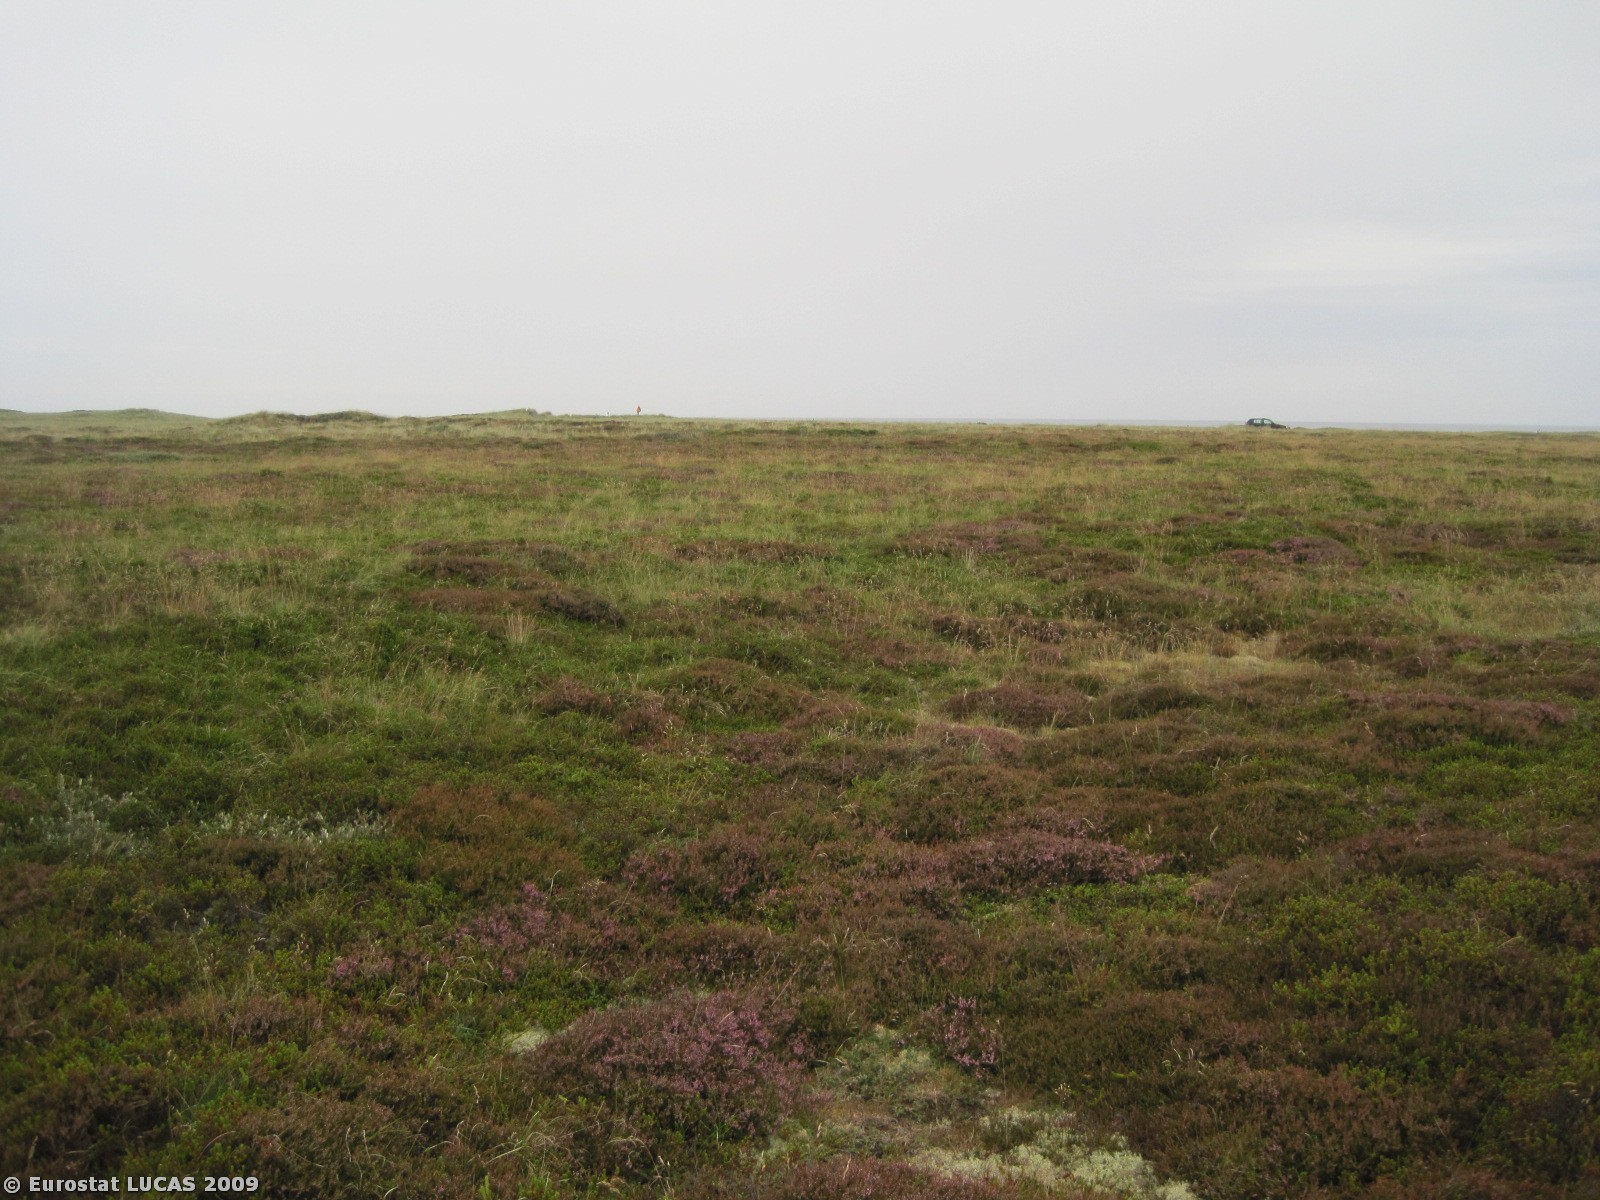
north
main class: Grassland
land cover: Grassland without tree/shrub cover
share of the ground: > 75 %
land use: Nature reserves
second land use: Amenities, museums, leisure
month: July
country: DK
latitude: 57.0984
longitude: 8.7309
